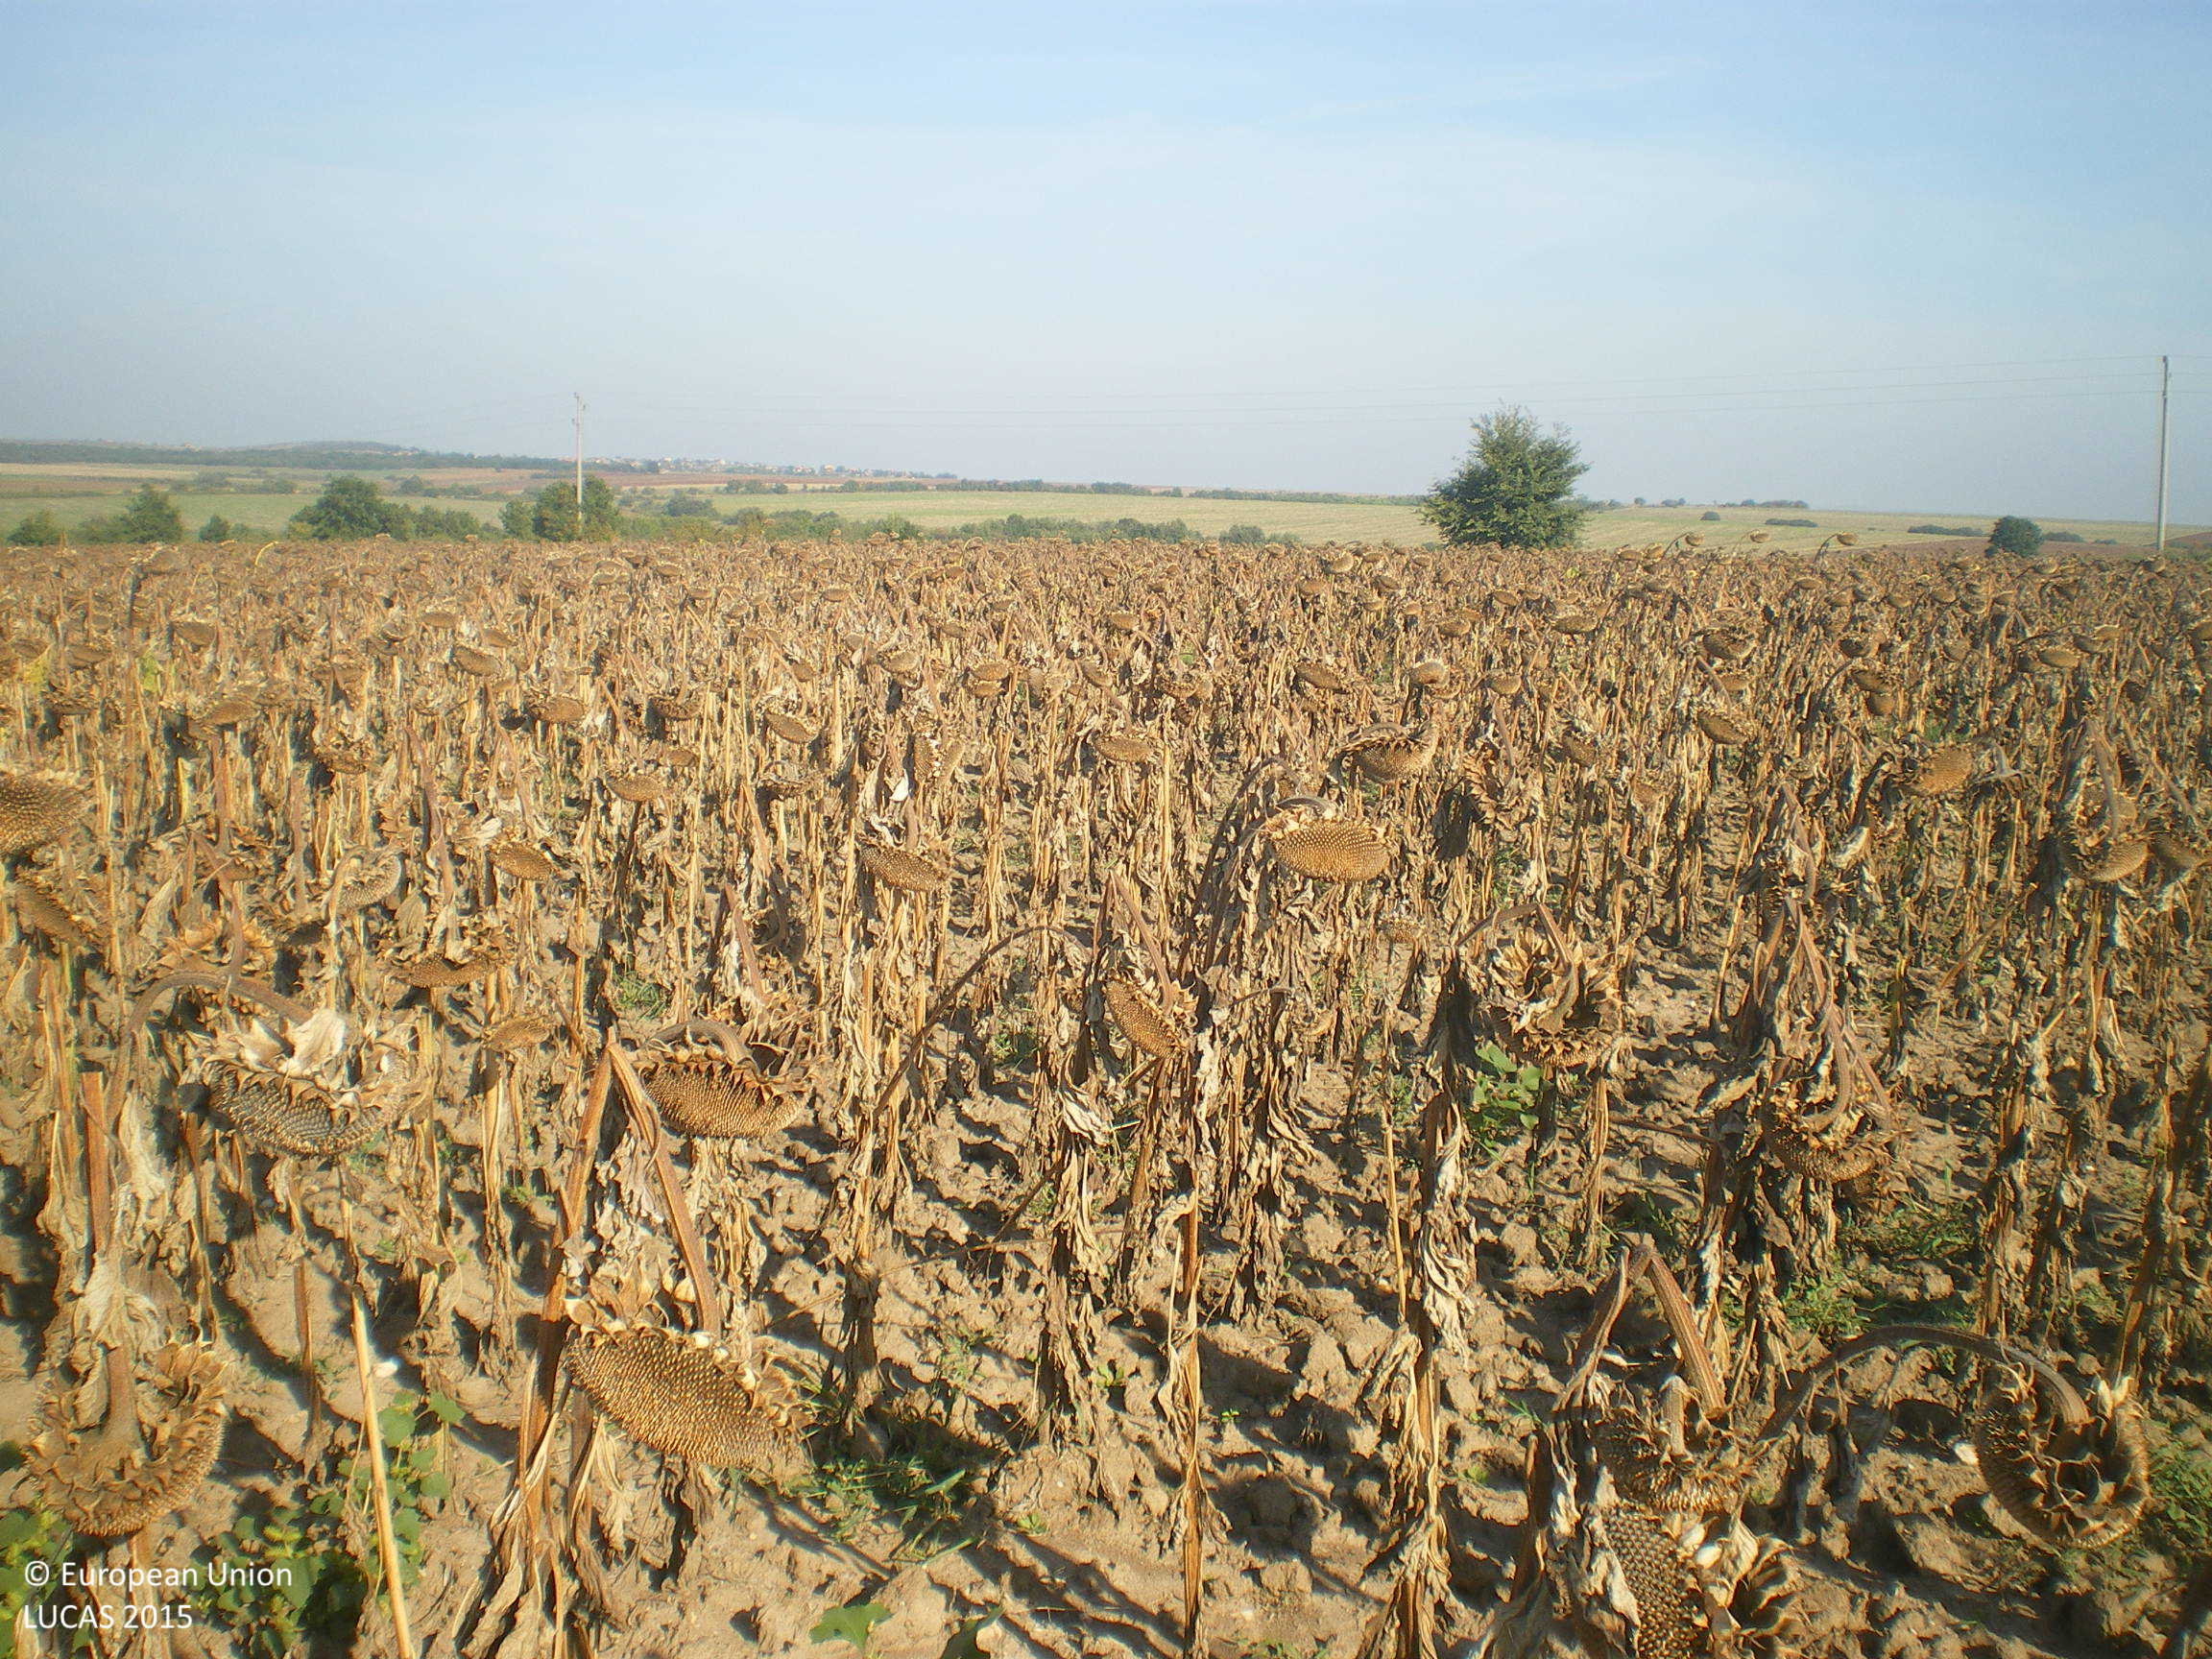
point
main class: Cropland
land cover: Sunflower
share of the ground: > 75 %
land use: Agriculture (excluding fallow land and kitchen gardens)
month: September
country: BG
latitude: 41.9837
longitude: 25.6242
